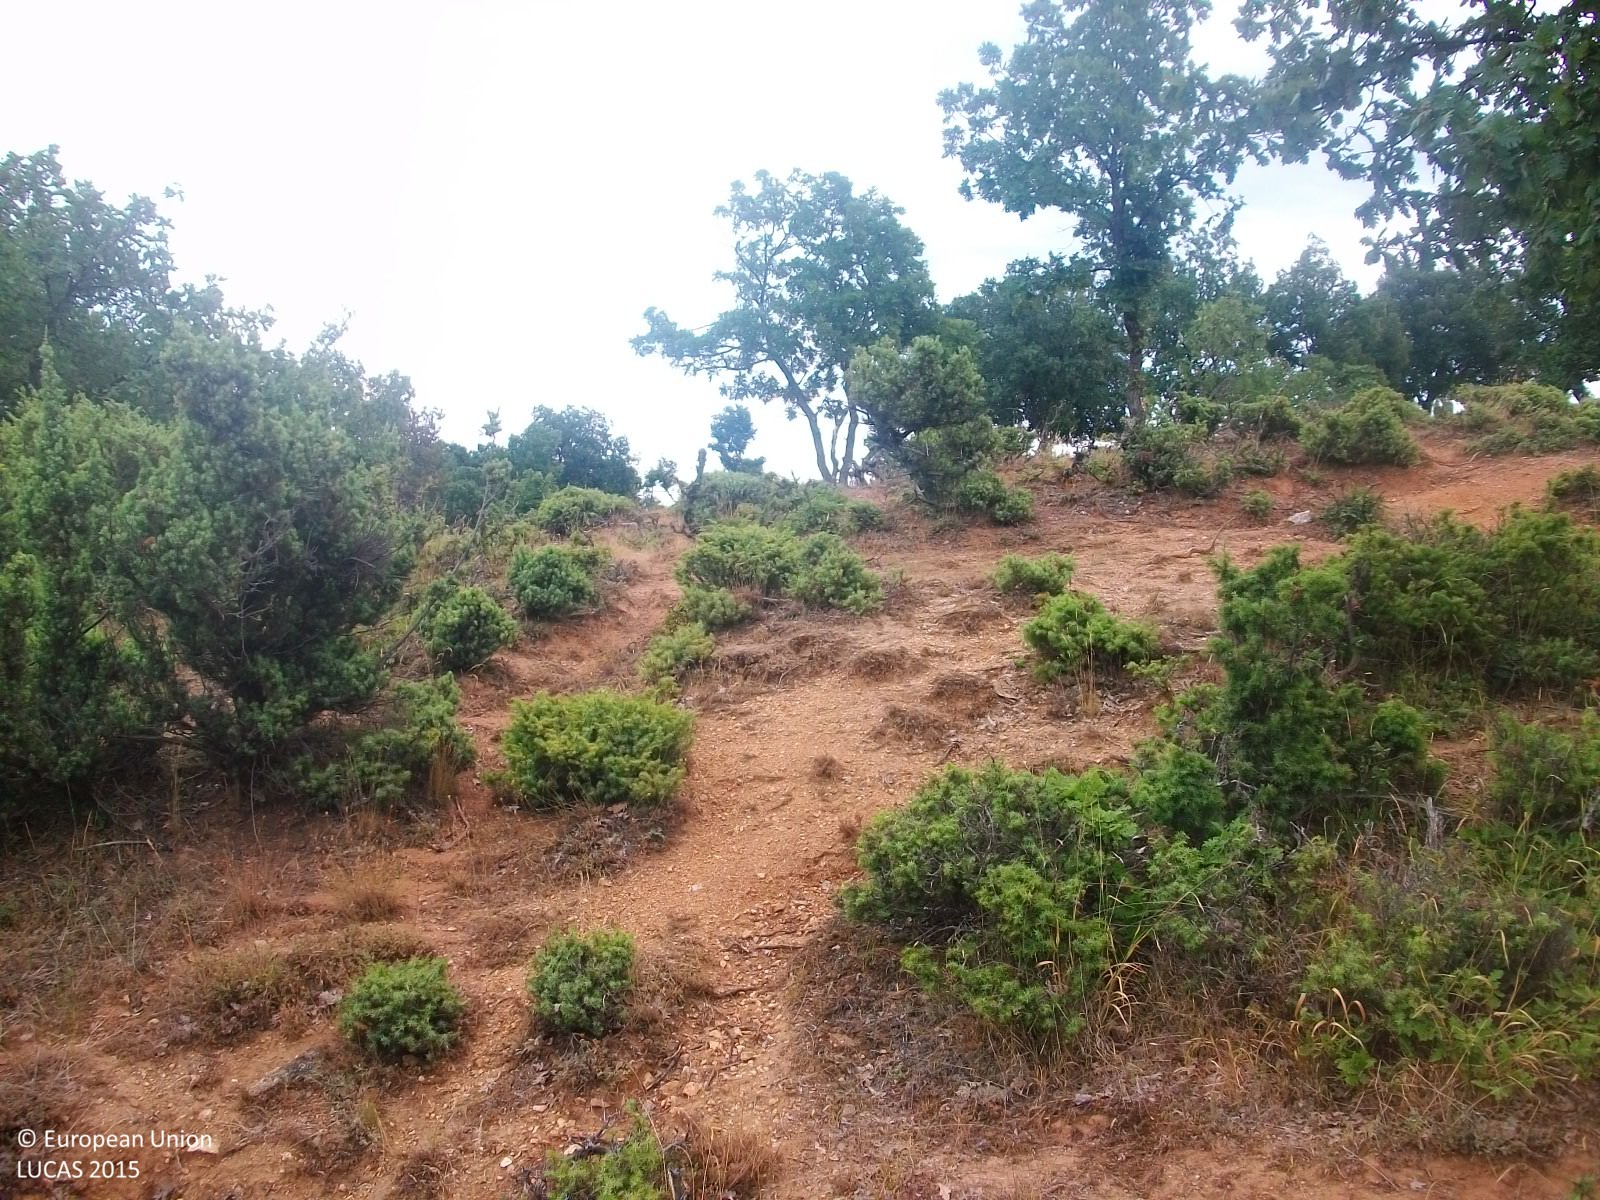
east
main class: Woodland
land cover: Broadleaved woodland
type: thermophilous deciduous forest
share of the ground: 25 - 50 %
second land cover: Shrubland without tree cover
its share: 25 - 50 %
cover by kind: broadleaved forest trees 40 %, shrubs 30 %, consolidated bare surface 20 %, herbaceous plants 10 %
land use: Forestry
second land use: Agriculture (excluding fallow land and kitchen gardens)
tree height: > 5 m
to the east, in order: Broadleaved woodland; Shrubland without tree cover; Grassland without tree/shrub cover; Artificial constructions in urban areas; Tracks; Grassland without tree/shrub cover; Tracks; Grassland without tree/shrub cover; Tracks; Grassland without tree/shrub cover
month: August
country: GR
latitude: 41.3589
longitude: 26.1953
